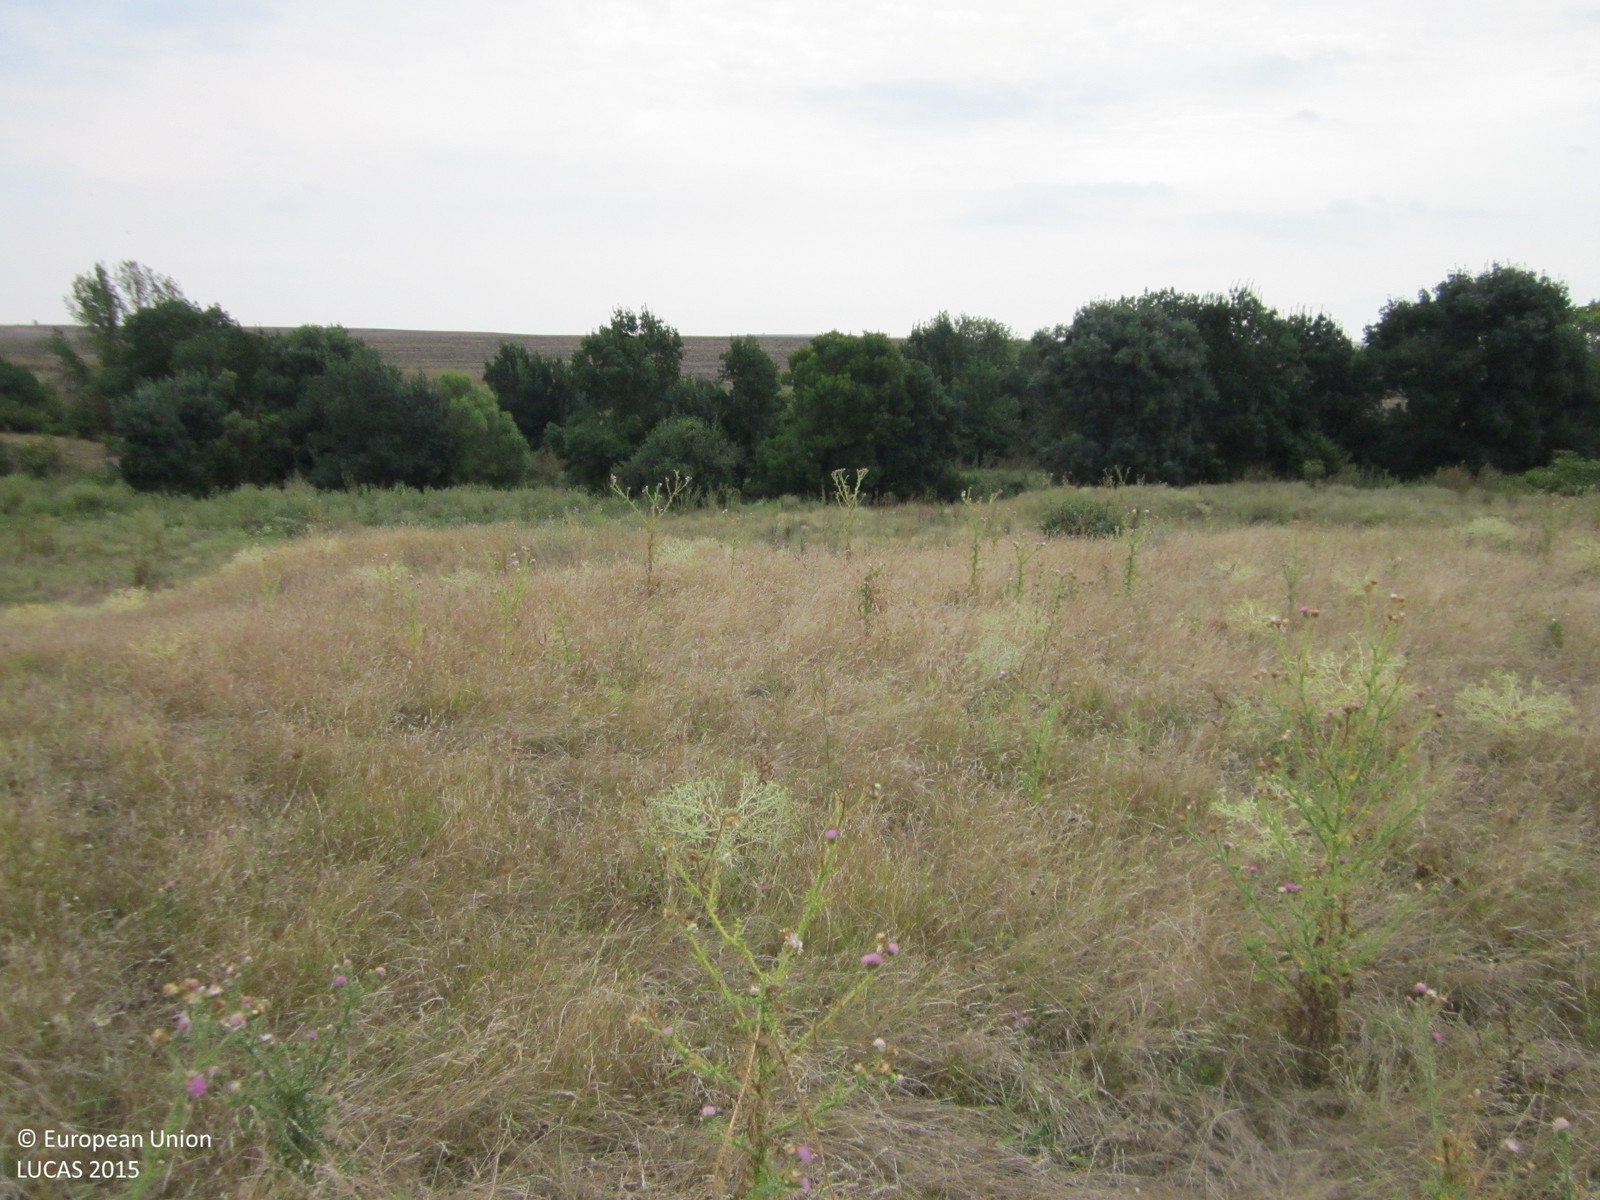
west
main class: Grassland
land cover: Grassland without tree/shrub cover
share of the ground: > 75 %
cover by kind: herbaceous plants 95 %, shrubs 5 %
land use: Agriculture (excluding fallow land and kitchen gardens)
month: August
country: BG
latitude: 42.4967
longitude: 26.9810
